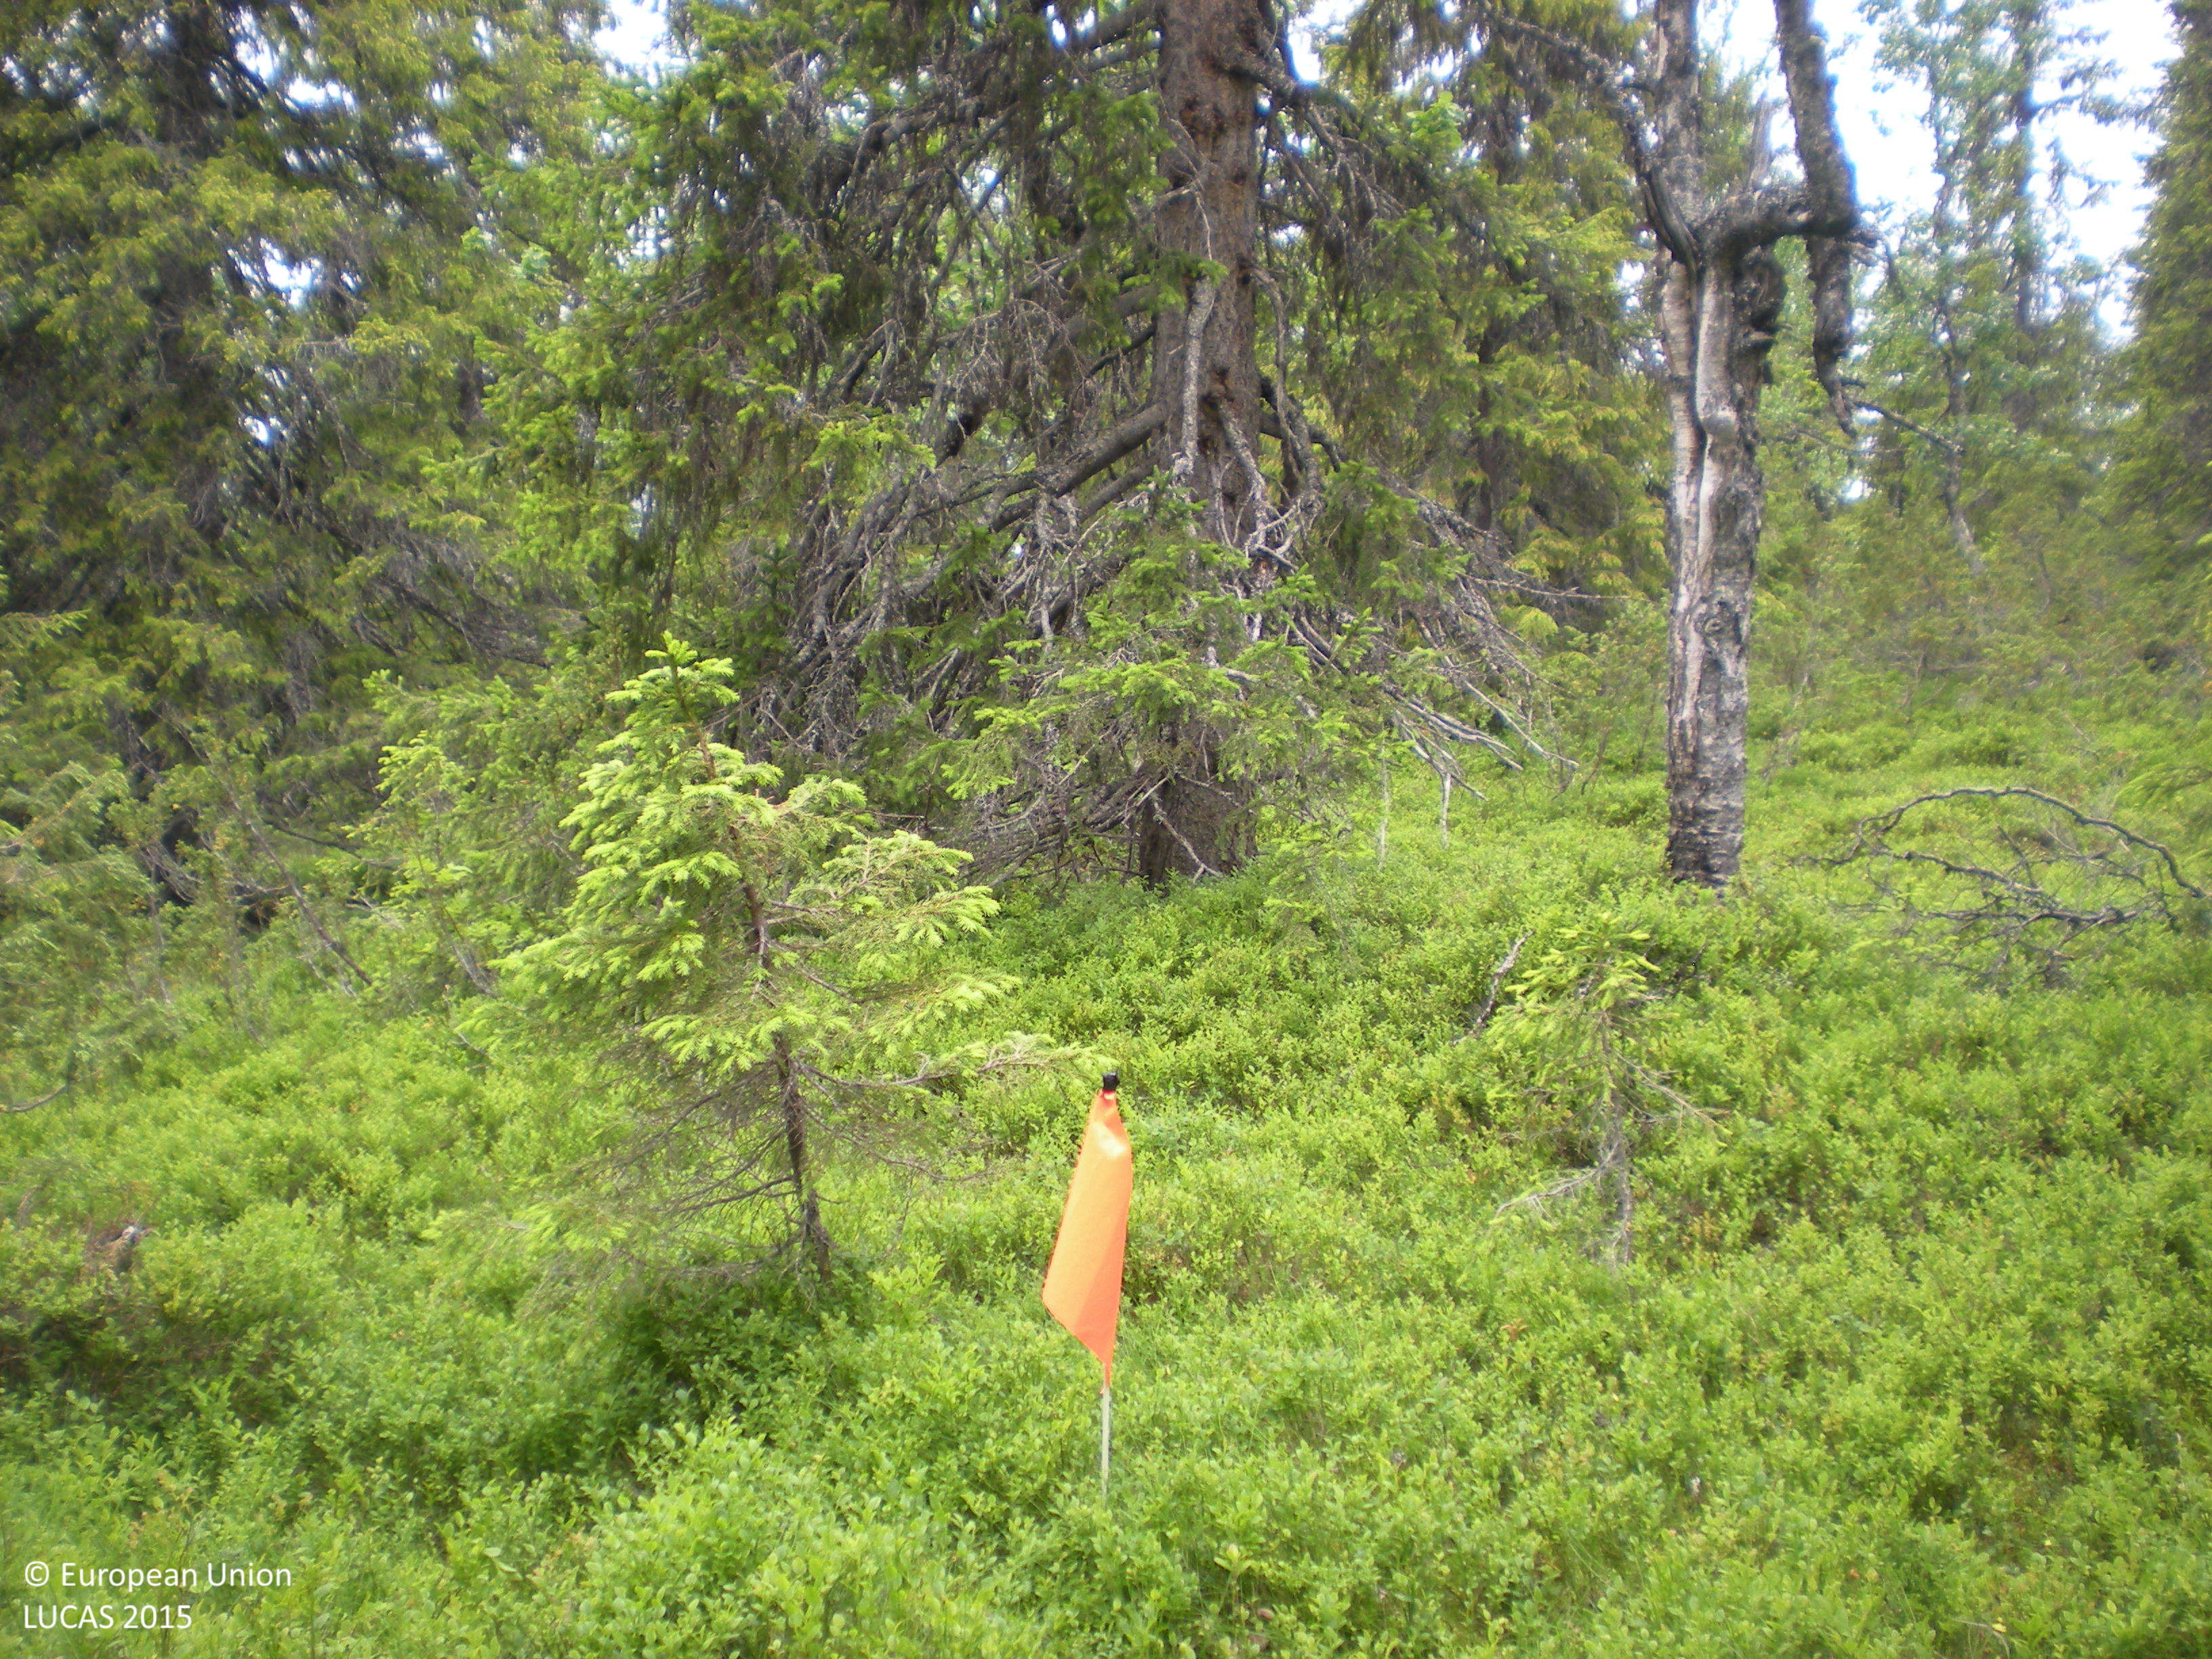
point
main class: Woodland
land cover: Spruce dominated mixed woodland
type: boreal forest
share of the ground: 50 - 75 %
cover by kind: coniferous forest trees 50 %, broadleaved forest trees 20 %, shrubs 20 %, herbaceous plants 5 %, lichens and mosses 5 %
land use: Forestry
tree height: > 5 m
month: July
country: SE
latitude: 65.9297
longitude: 18.2399
